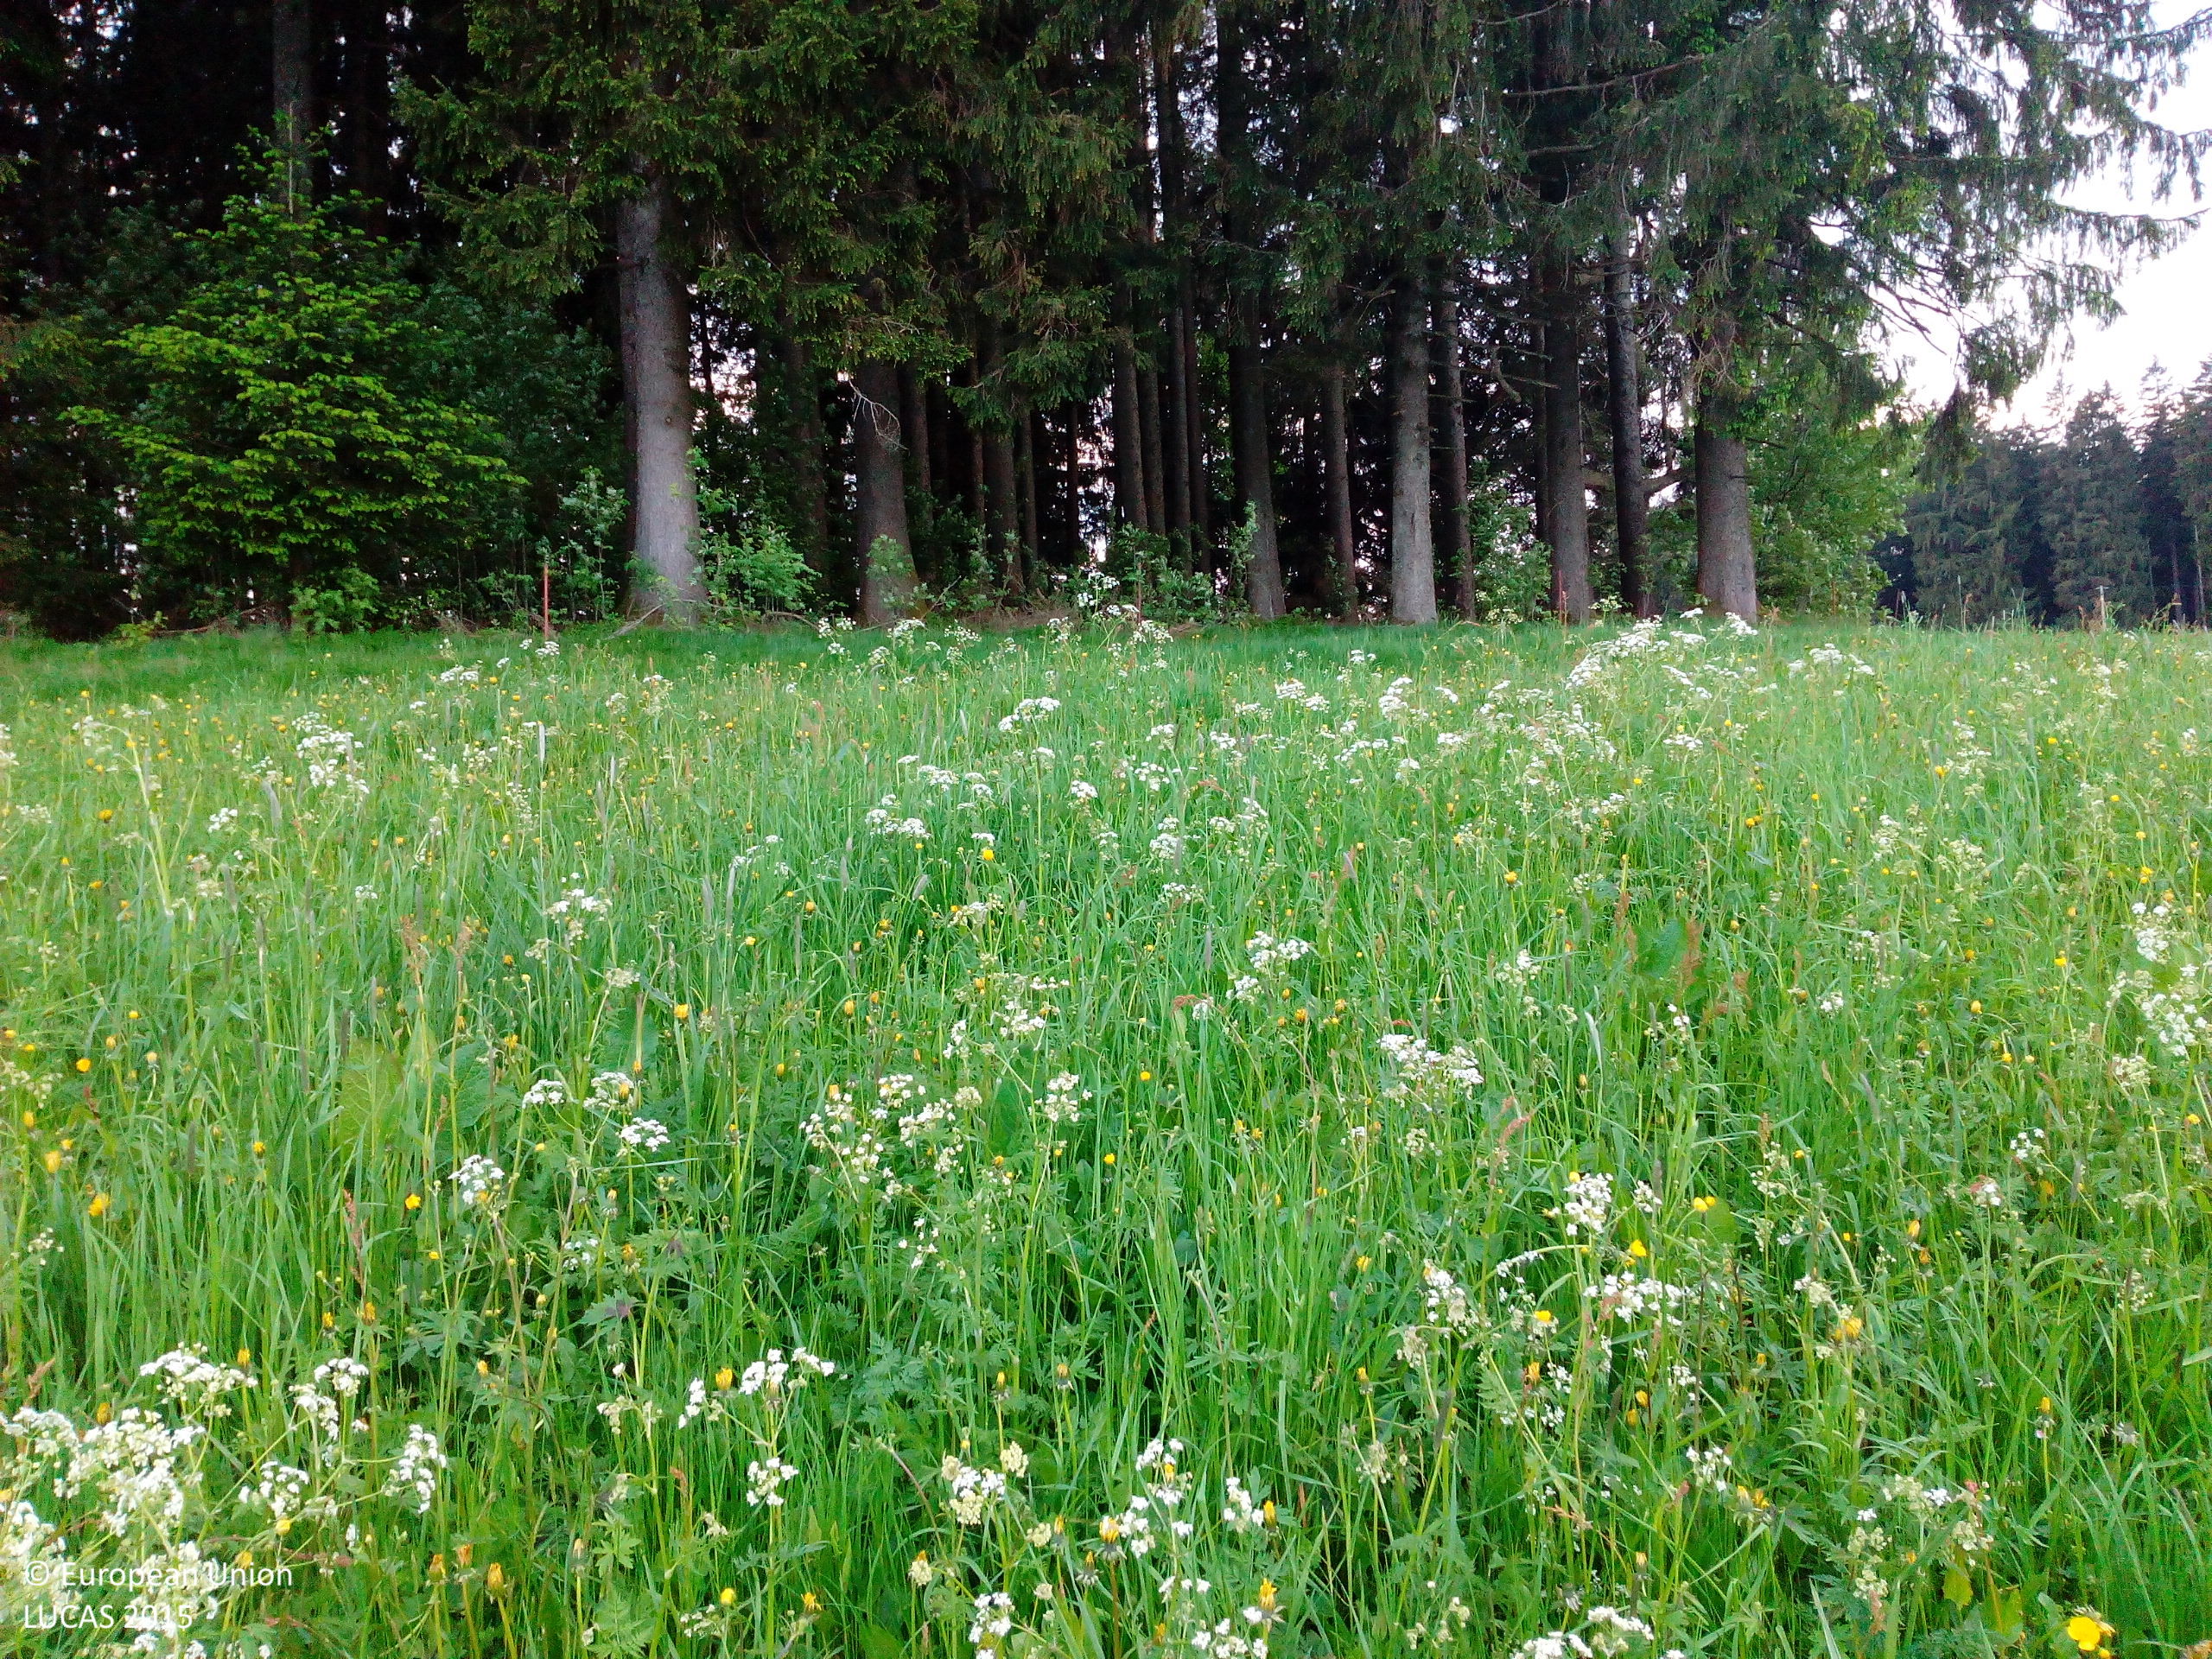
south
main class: Grassland
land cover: Grassland without tree/shrub cover
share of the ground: > 75 %
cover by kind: herbaceous plants 100 %
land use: Agriculture (excluding fallow land and kitchen gardens)
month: May
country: DE
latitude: 48.0278
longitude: 8.1371
